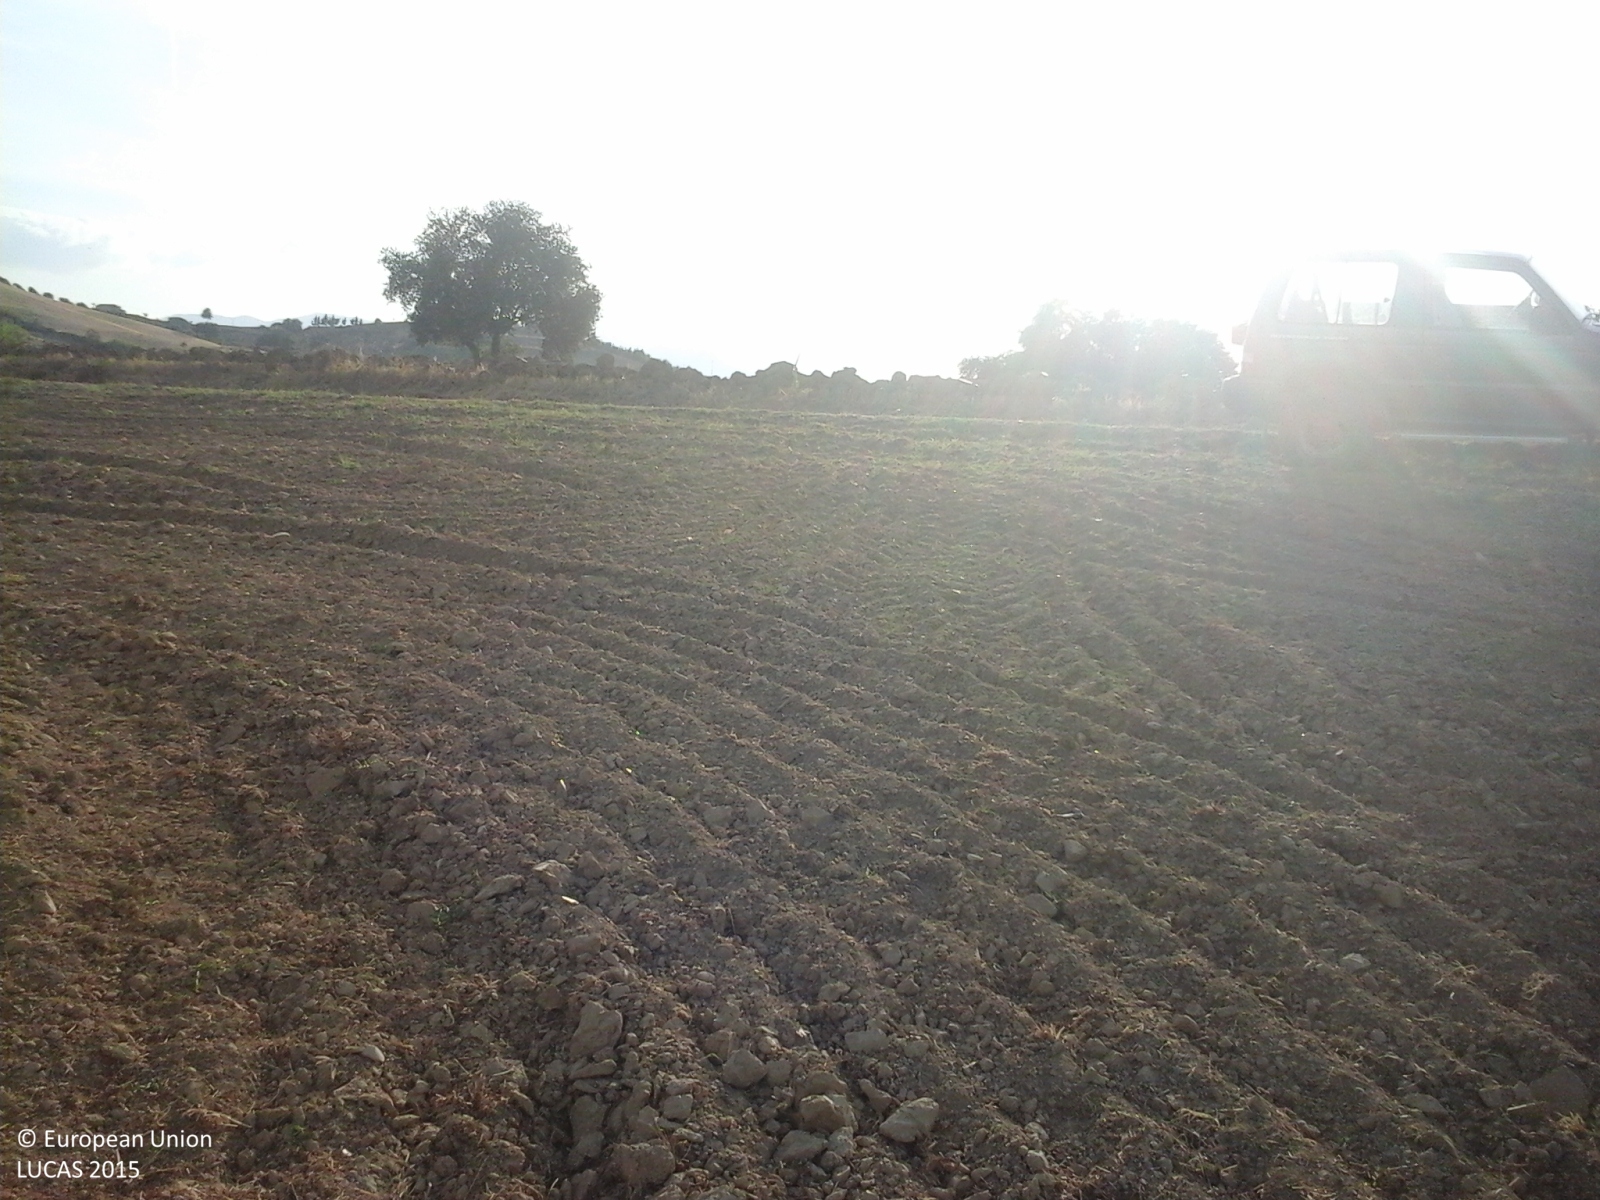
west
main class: Grassland
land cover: Spontaneously vegetated surfaces
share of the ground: > 75 %
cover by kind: herbaceous plants 80 %, unconsolidated bare surface 20 %
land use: Agriculture (excluding fallow land and kitchen gardens)
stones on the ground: < 10 %
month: August
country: IT
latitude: 42.4831
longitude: 14.0390
